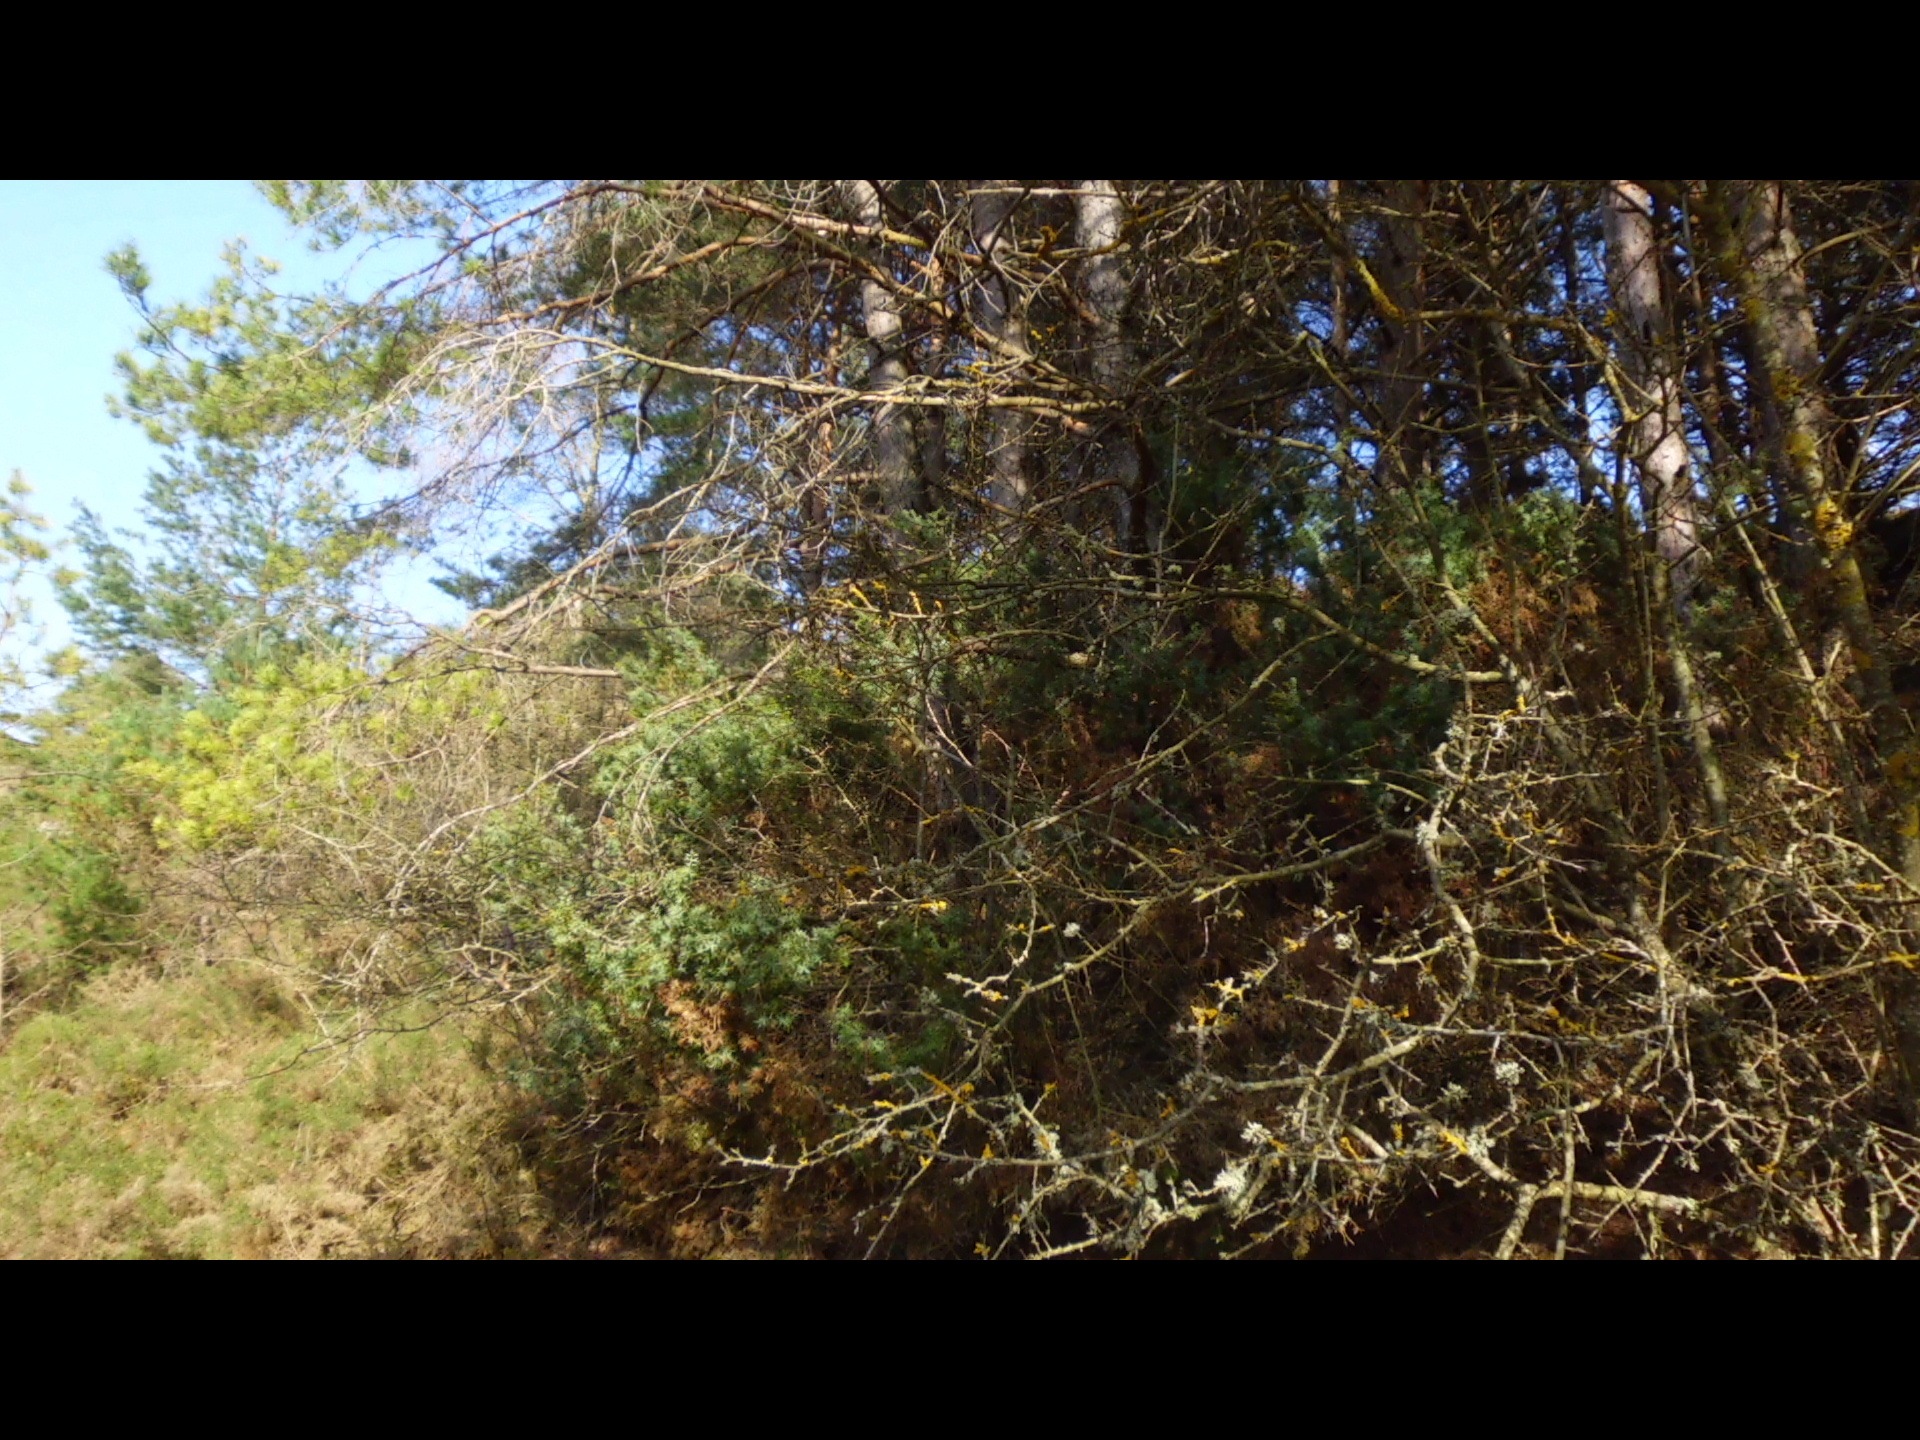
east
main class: Shrubland
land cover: Shrubland without tree cover
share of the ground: 50 - 75 %
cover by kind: herbaceous plants 65 %, shrubs 35 %
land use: Semi-natural and natural areas not in use
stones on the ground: 25 - 50 %
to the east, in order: Shrubland without tree cover; Pine dominated coniferous woodland; Grassland without tree/shrub cover
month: April
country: ES
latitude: 42.5927
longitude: -3.7247
